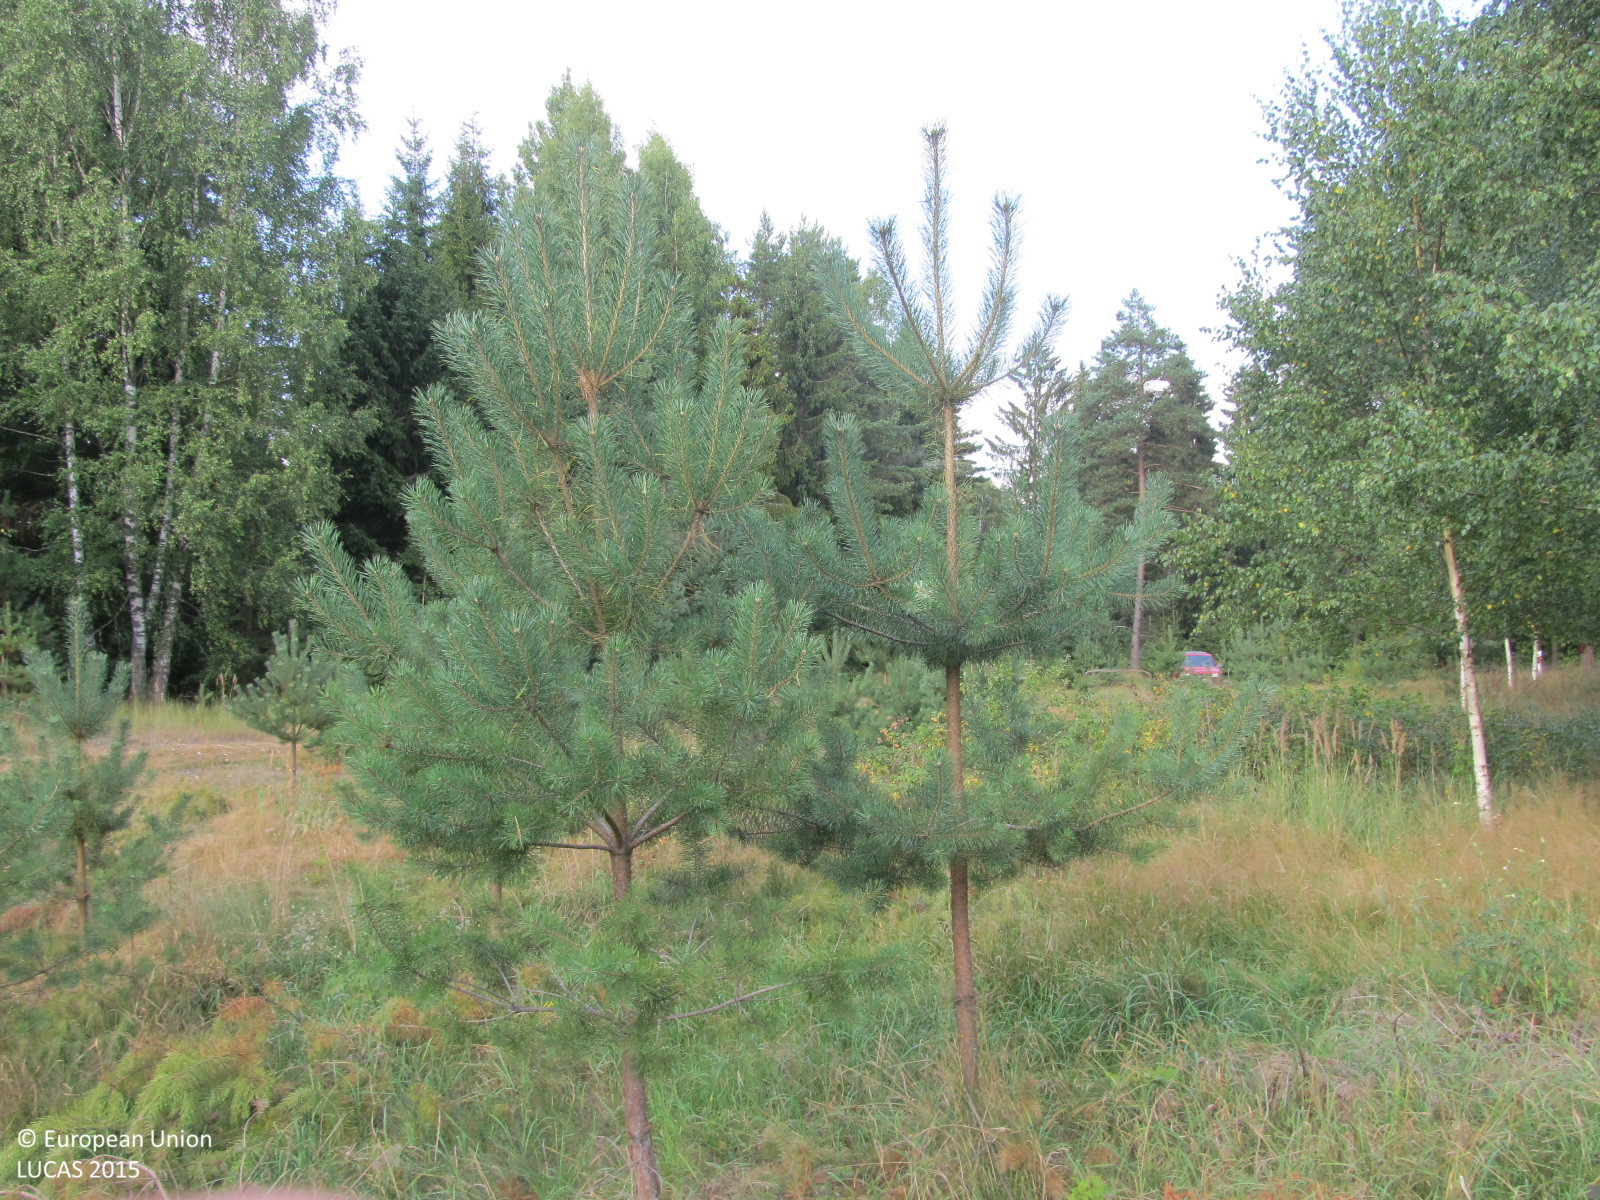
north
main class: Woodland
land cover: Pine dominated coniferous woodland
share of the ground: 25 - 50 %
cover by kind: herbaceous plants 70 %, coniferous forest trees 30 %
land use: Forestry
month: August
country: LT
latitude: 55.8214
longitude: 23.1107
